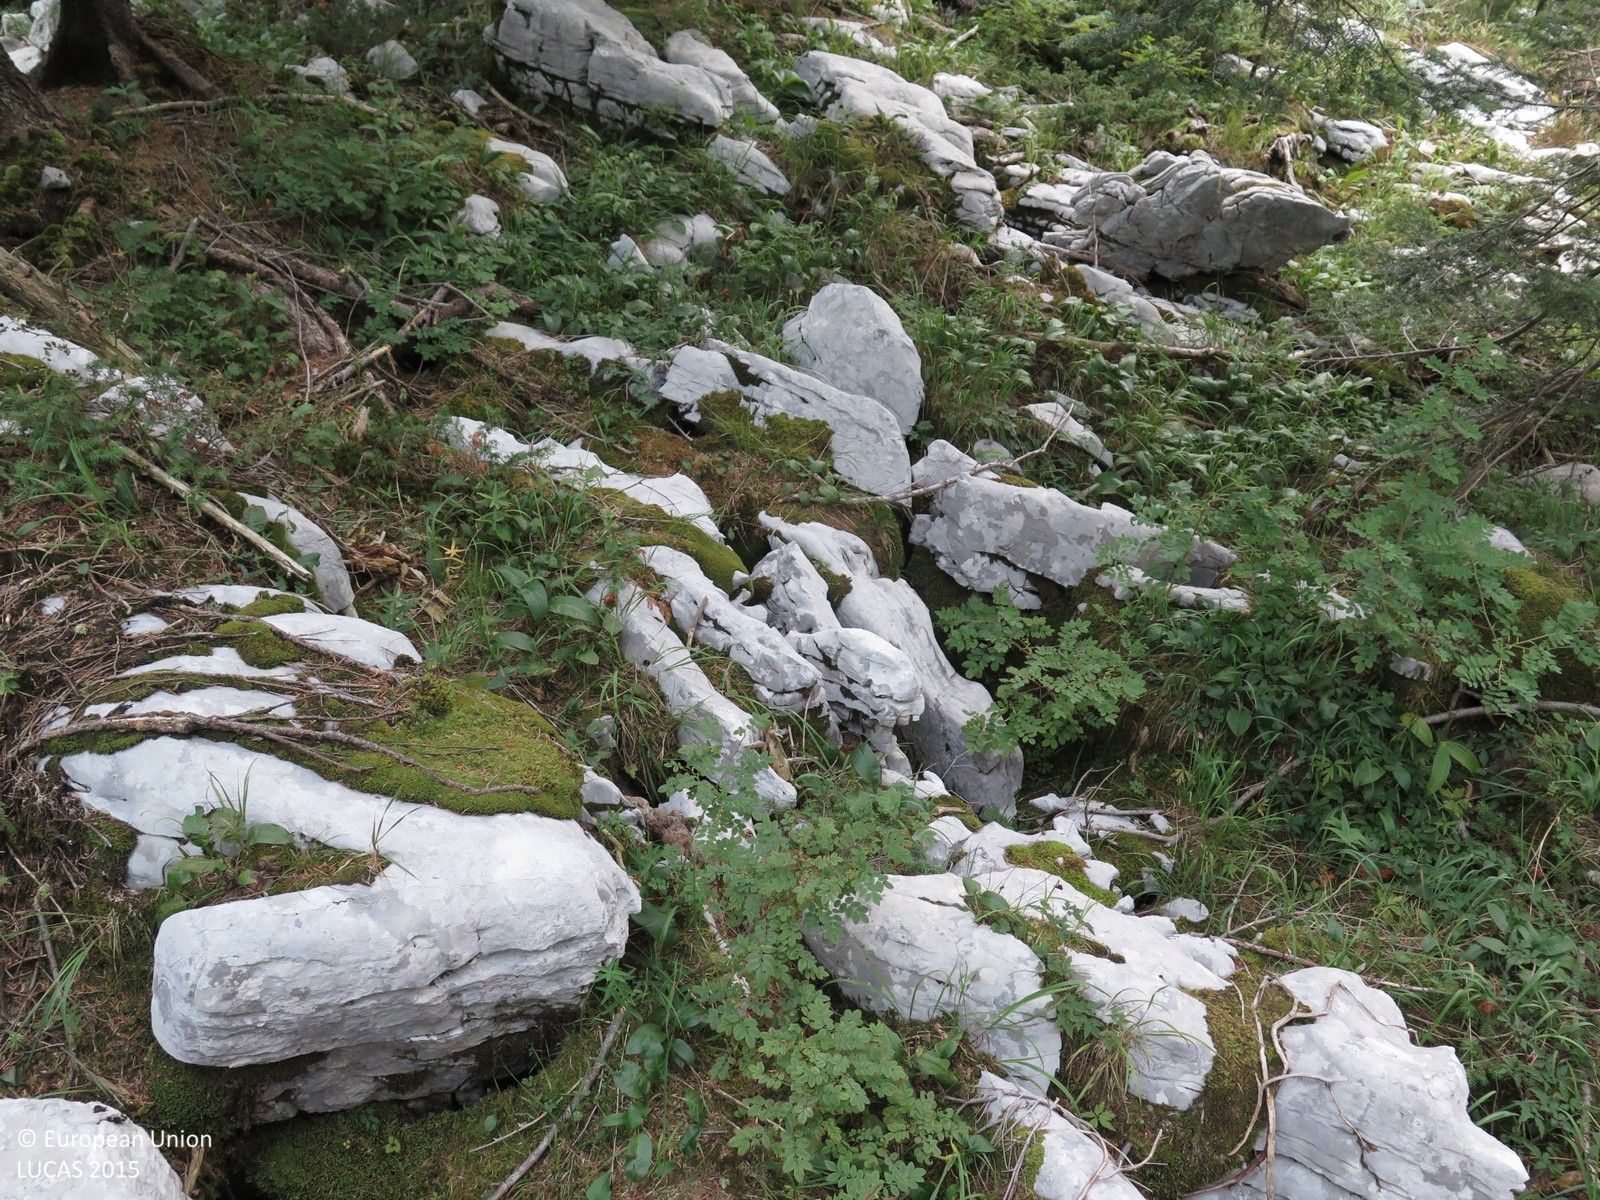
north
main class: Woodland
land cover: Other mixed woodland
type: coniferous forest of the mediterranean region
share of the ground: > 75 %
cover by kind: coniferous forest trees 70 %, broadleaved forest trees 25 %, unconsolidated bare surface 5 %
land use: Forestry
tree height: > 5 m
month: August
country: HR
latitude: 45.4960
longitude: 14.5638
